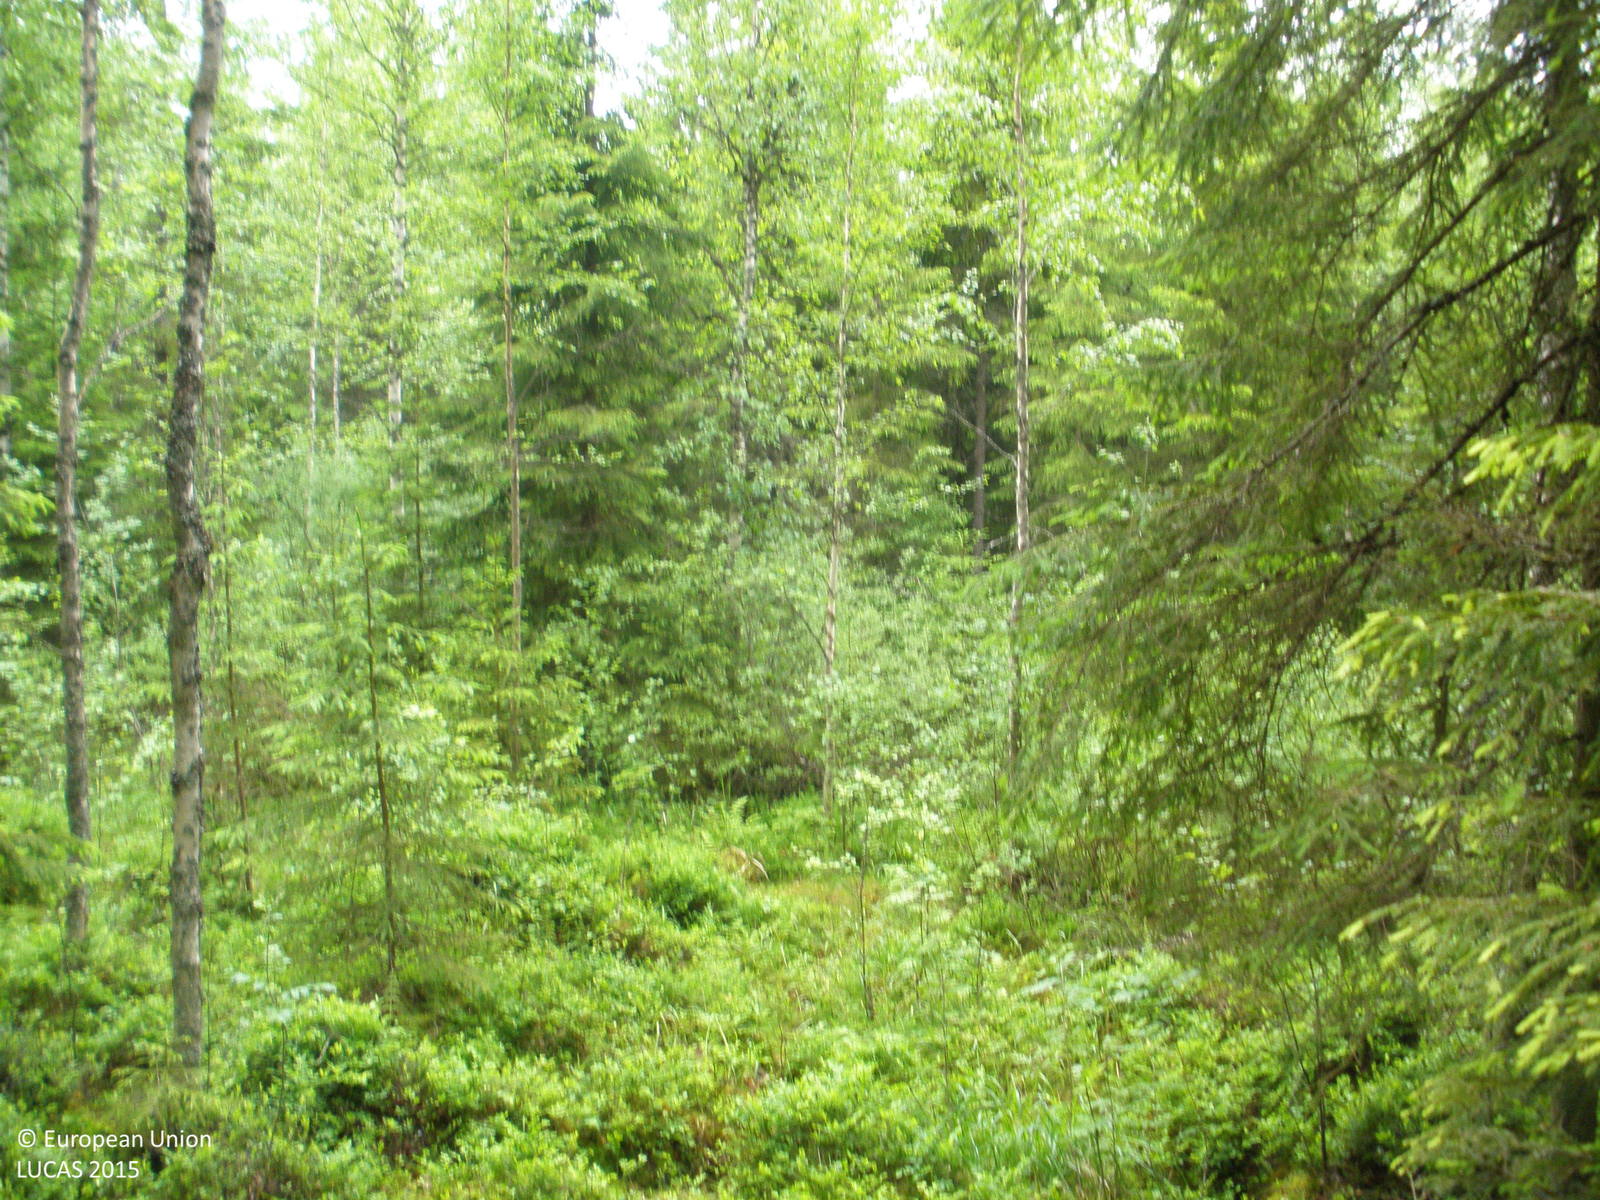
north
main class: Woodland
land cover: Spruce dominated coniferous woodland
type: boreal forest
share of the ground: > 75 %
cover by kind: coniferous forest trees 85 %, lichens and mosses 10 %, herbaceous plants 5 %
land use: Forestry
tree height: > 5 m
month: June
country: FI
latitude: 61.0222
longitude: 23.5735
